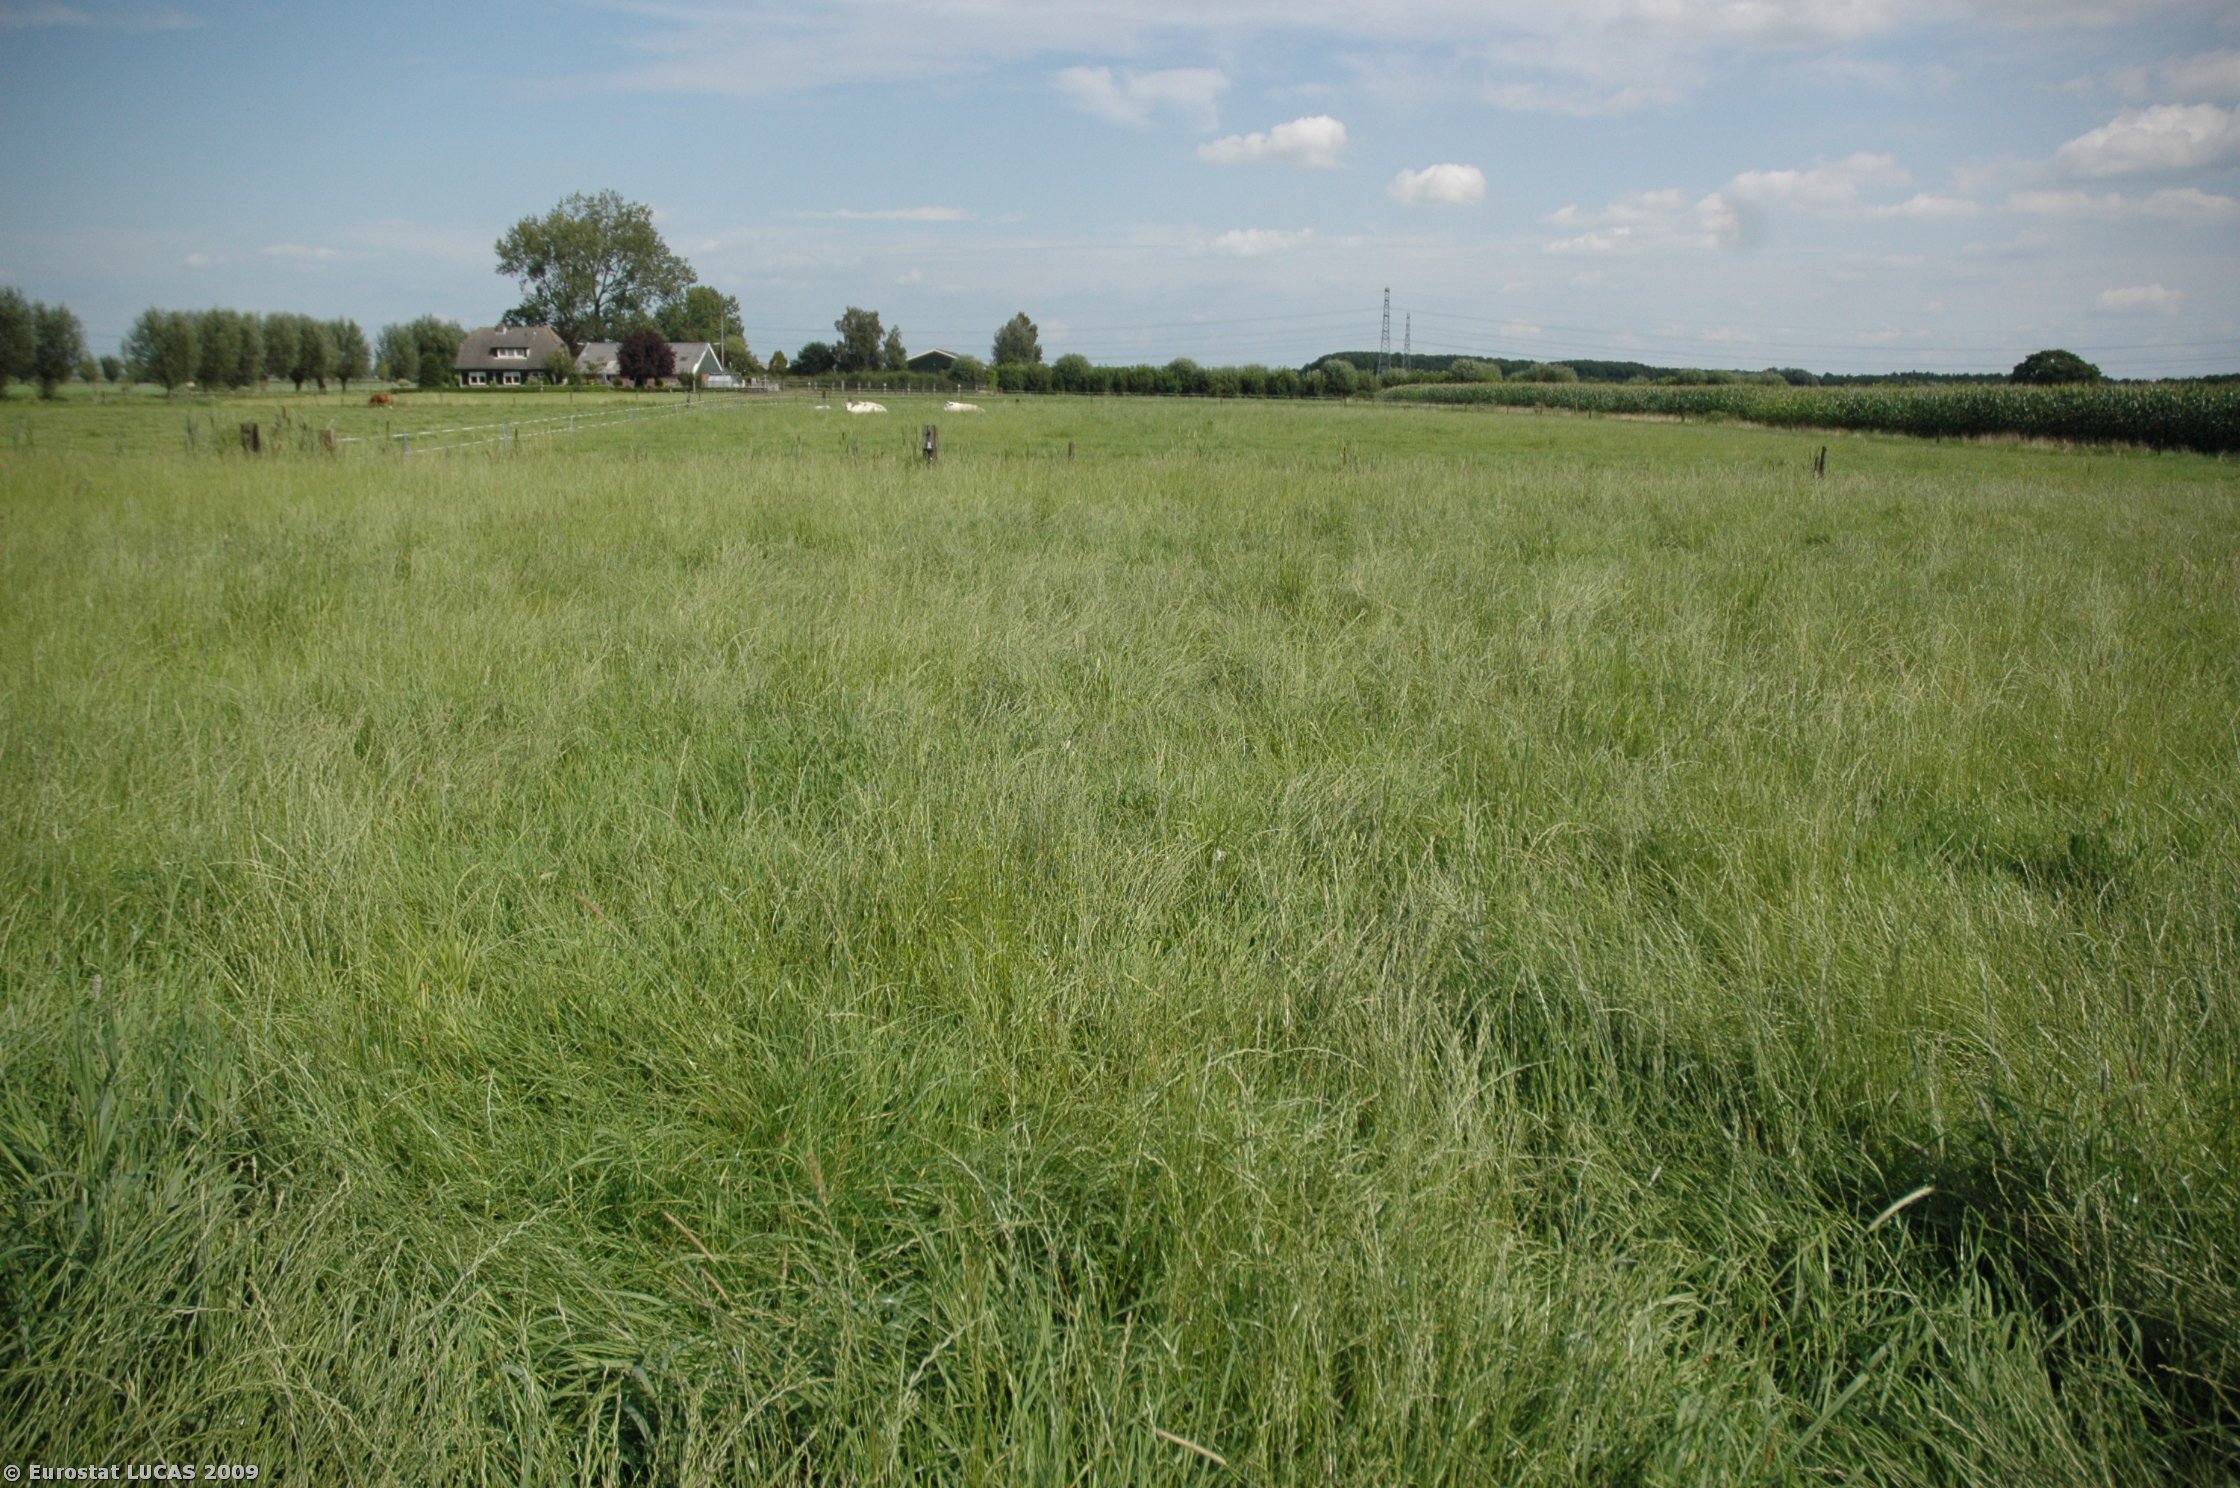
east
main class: Grassland
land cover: Grassland without tree/shrub cover
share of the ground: > 75 %
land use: Agriculture (excluding fallow land and kitchen gardens)
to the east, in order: Grassland without tree/shrub cover; Fences; Ditches and canals; Fences; Grassland without tree/shrub cover; Fences; Ditches and canals; Fences; Grassland without tree/shrub cover; Fences; Grass margins; Ditches and canals; Grass margins; Broadleaved woodland; Fences; Grassland without tree/shrub cover
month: August
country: NL
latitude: 52.4026
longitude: 6.0749
